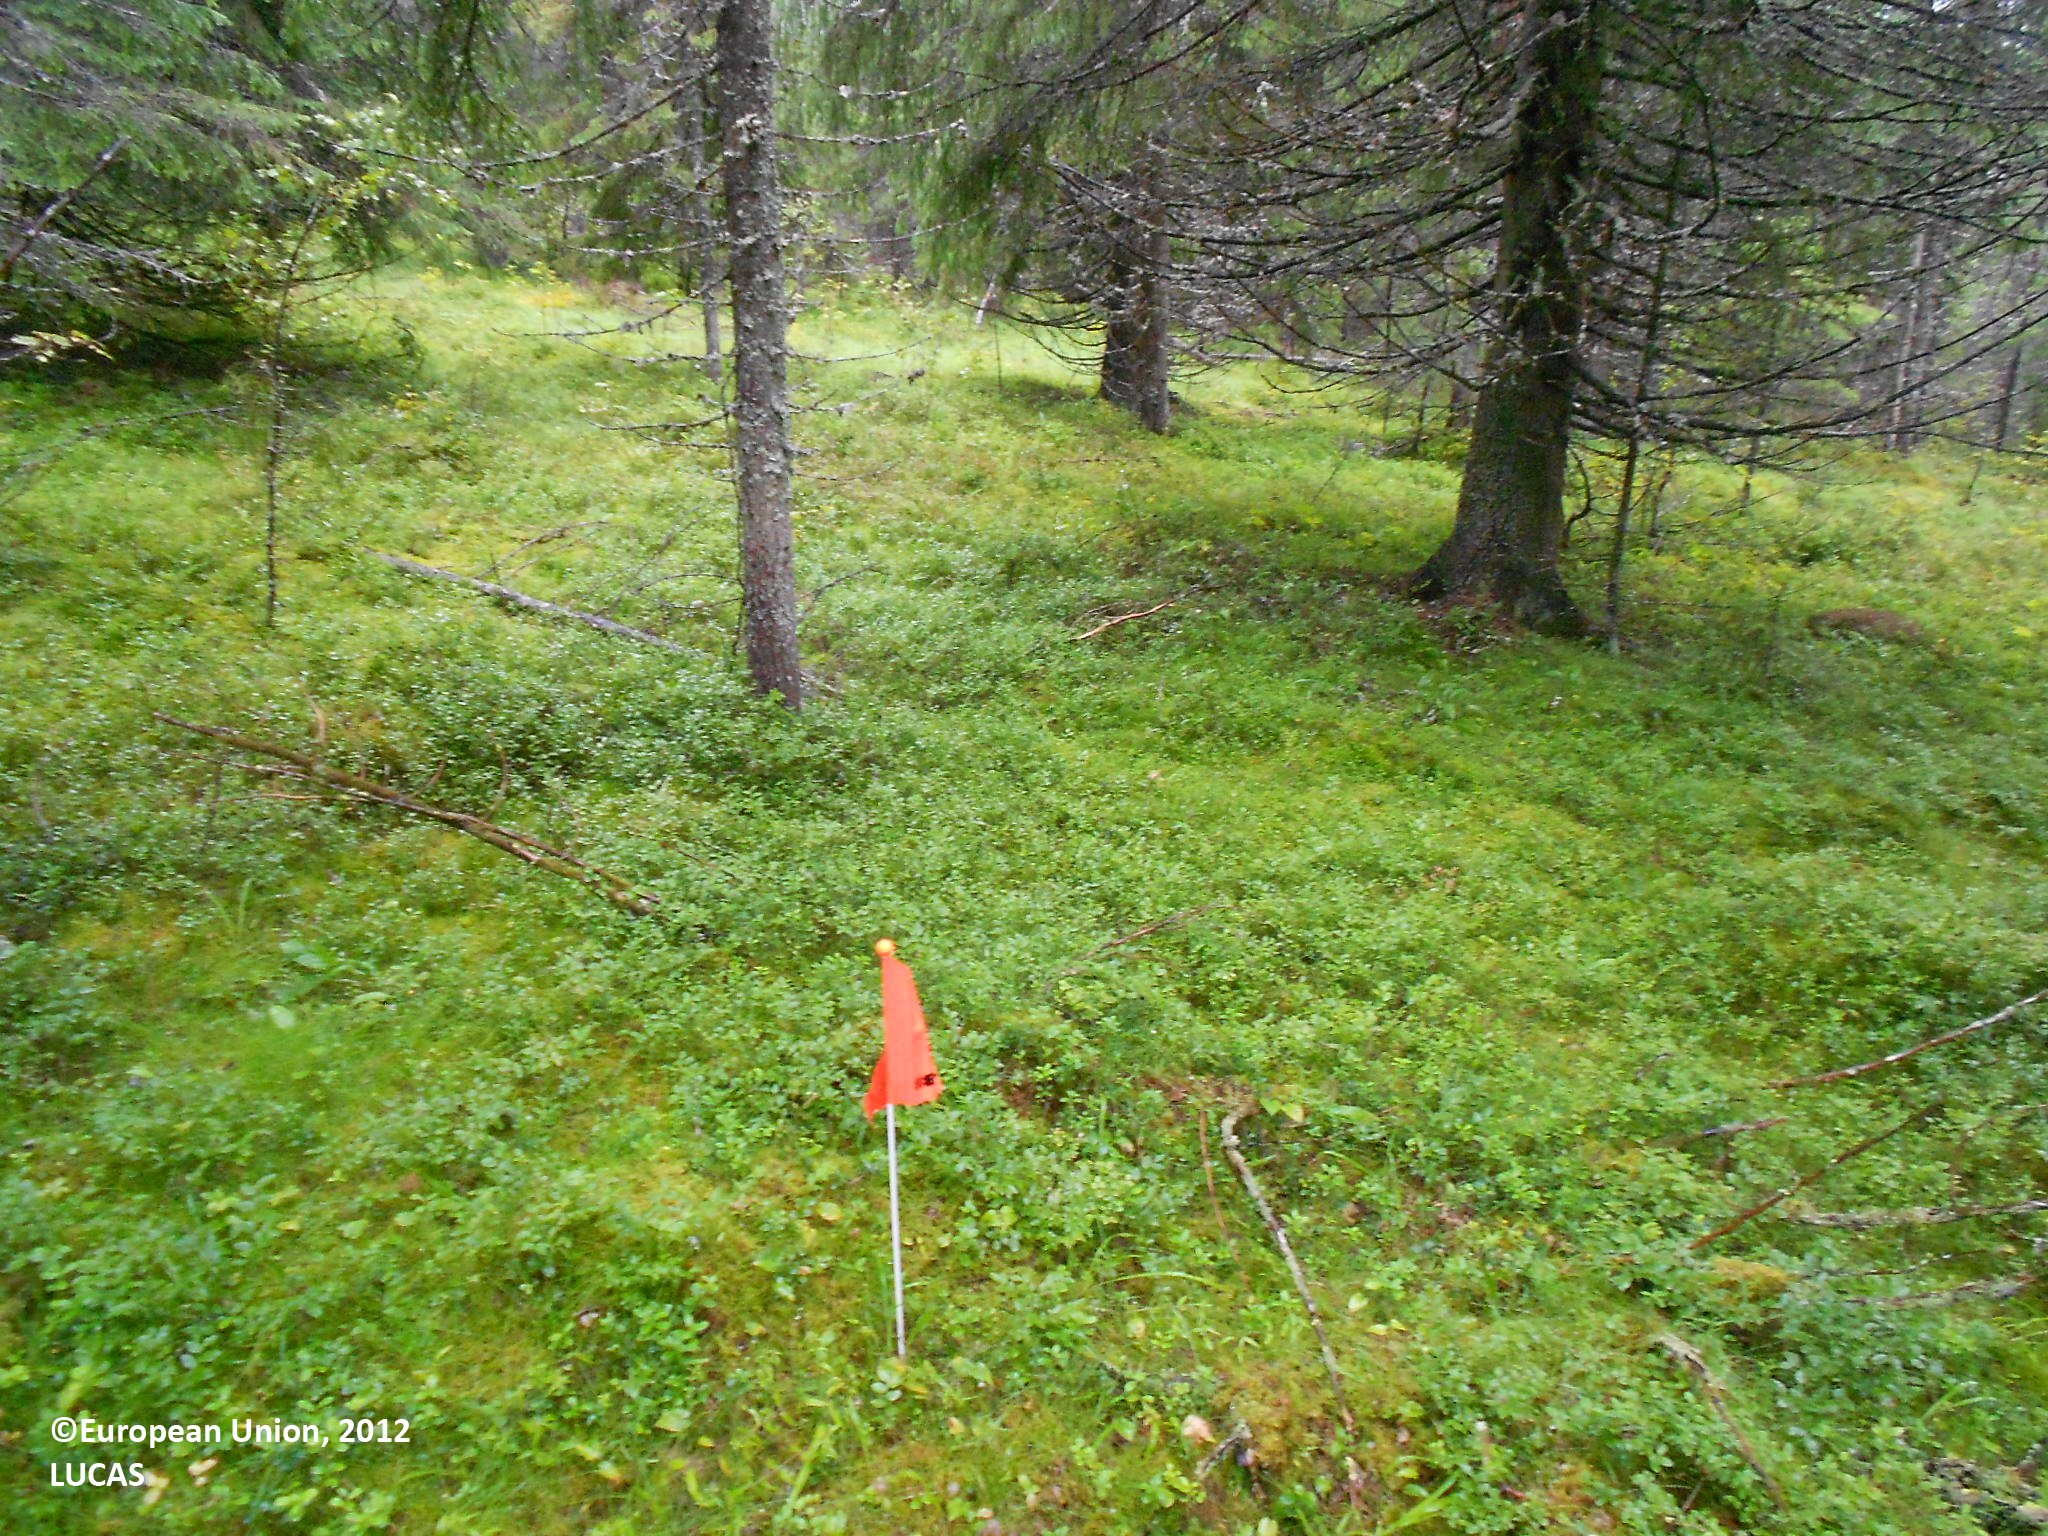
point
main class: Woodland
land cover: Spruce dominated coniferous woodland
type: boreal forest
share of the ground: 50 - 75 %
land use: Forestry
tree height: > 5 m
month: August
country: FI
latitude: 63.8984
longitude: 28.2874
